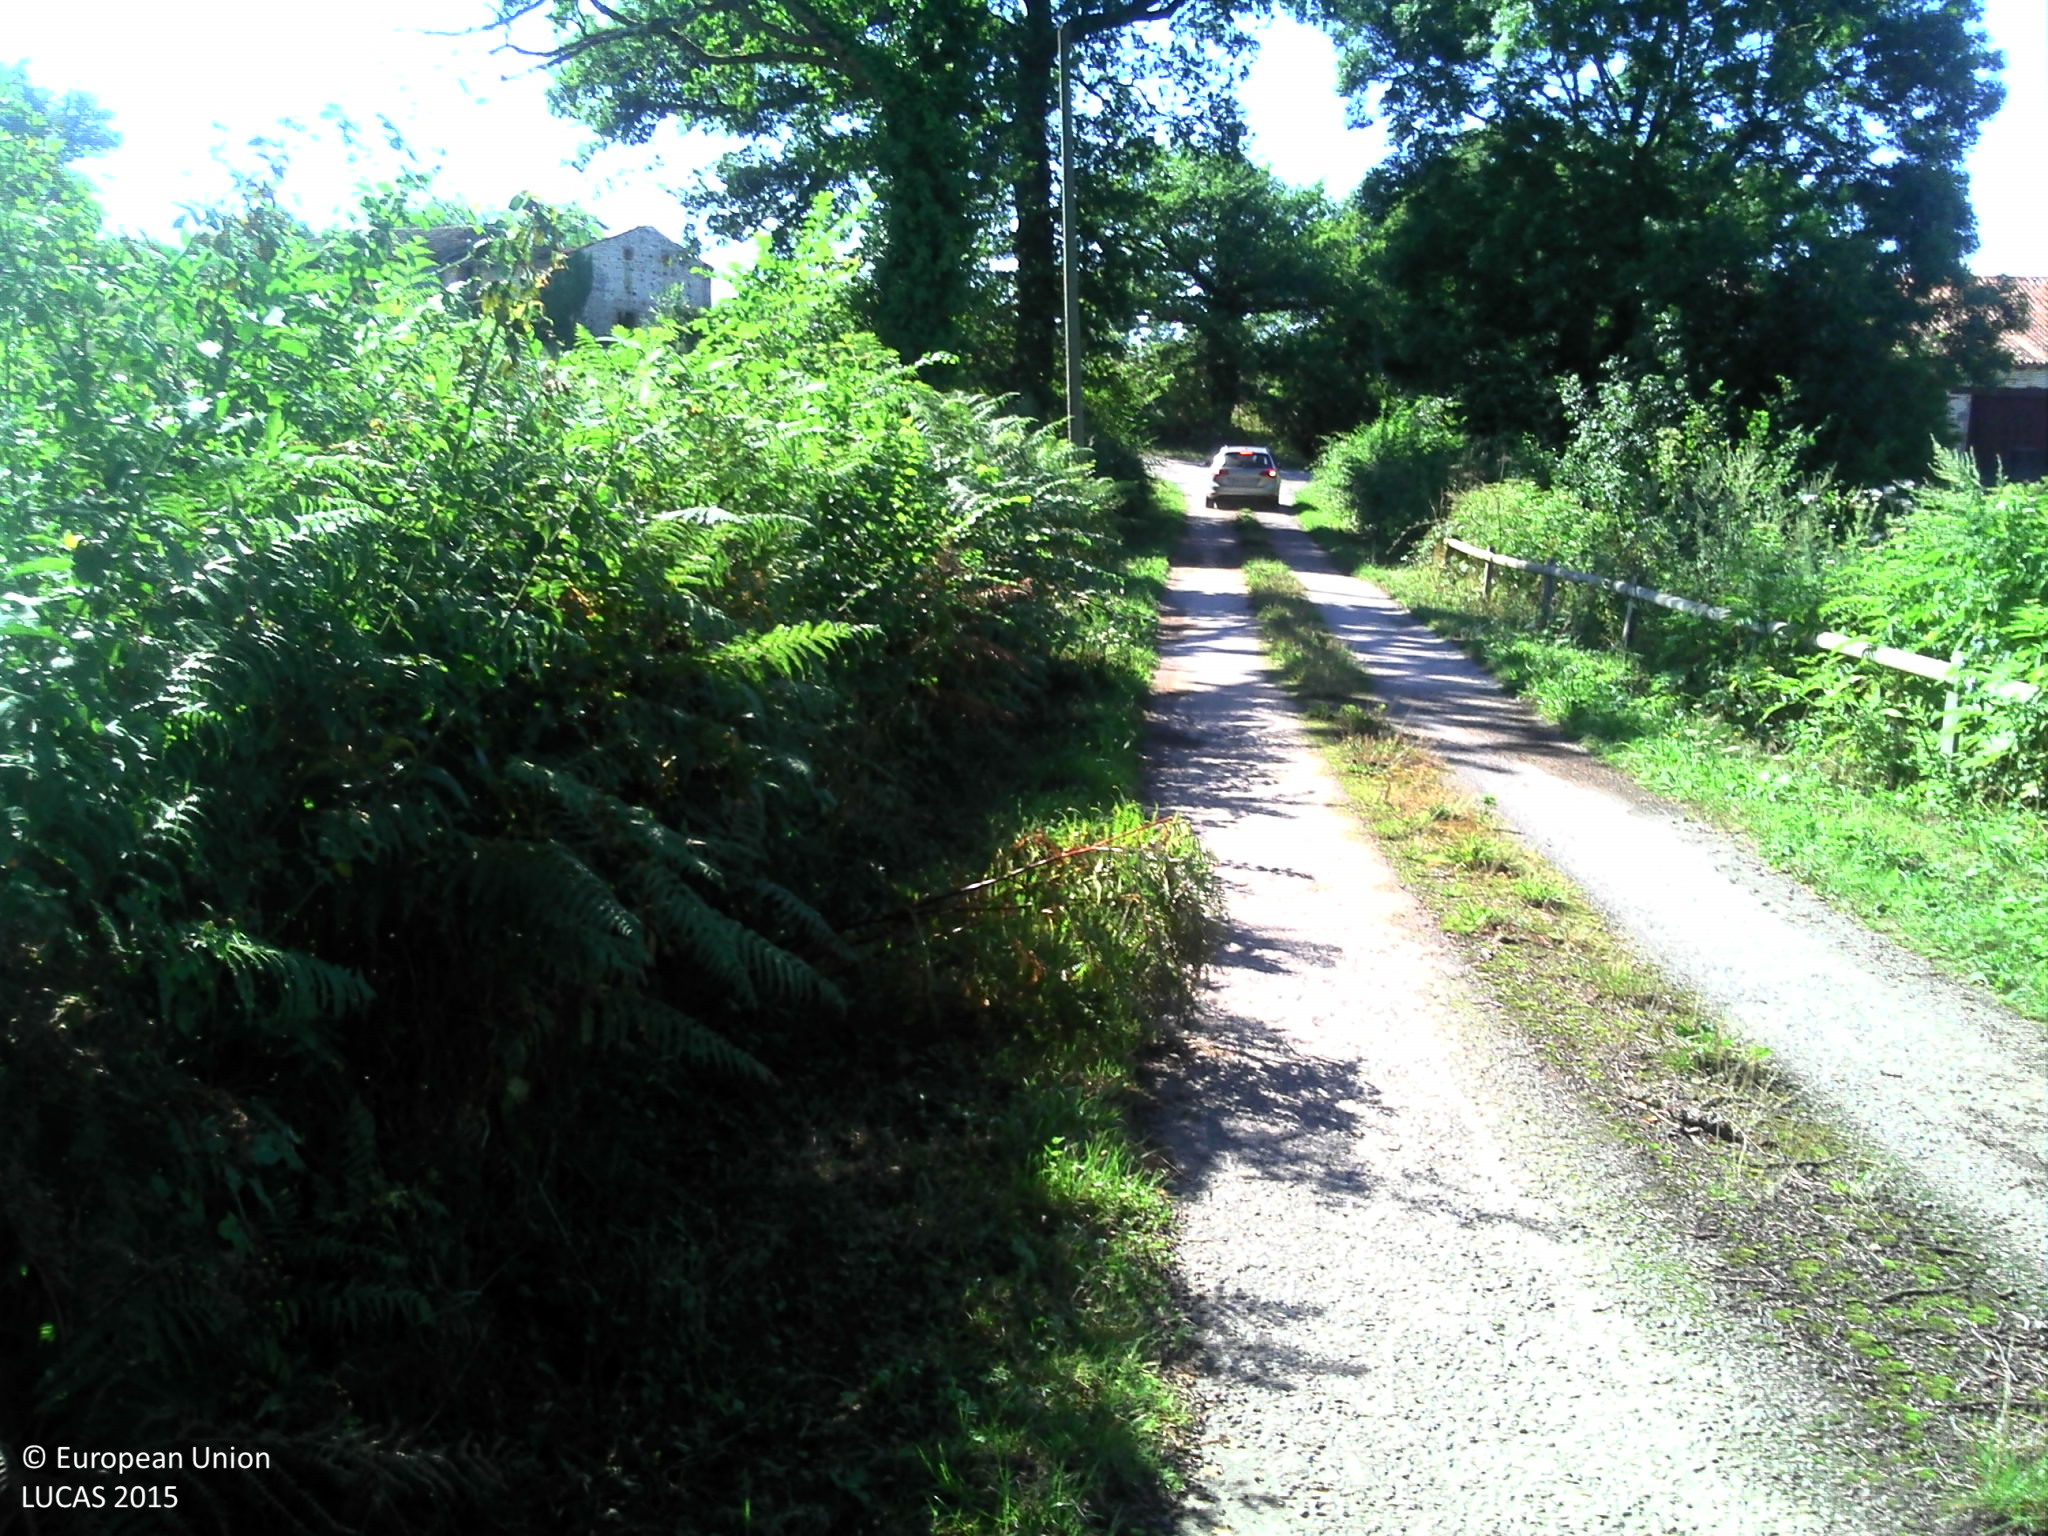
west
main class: Grassland
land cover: Grassland without tree/shrub cover
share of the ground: > 75 %
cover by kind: herbaceous plants 100 %
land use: Agriculture (excluding fallow land and kitchen gardens)
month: August
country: FR
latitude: 46.1470
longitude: 0.9376
